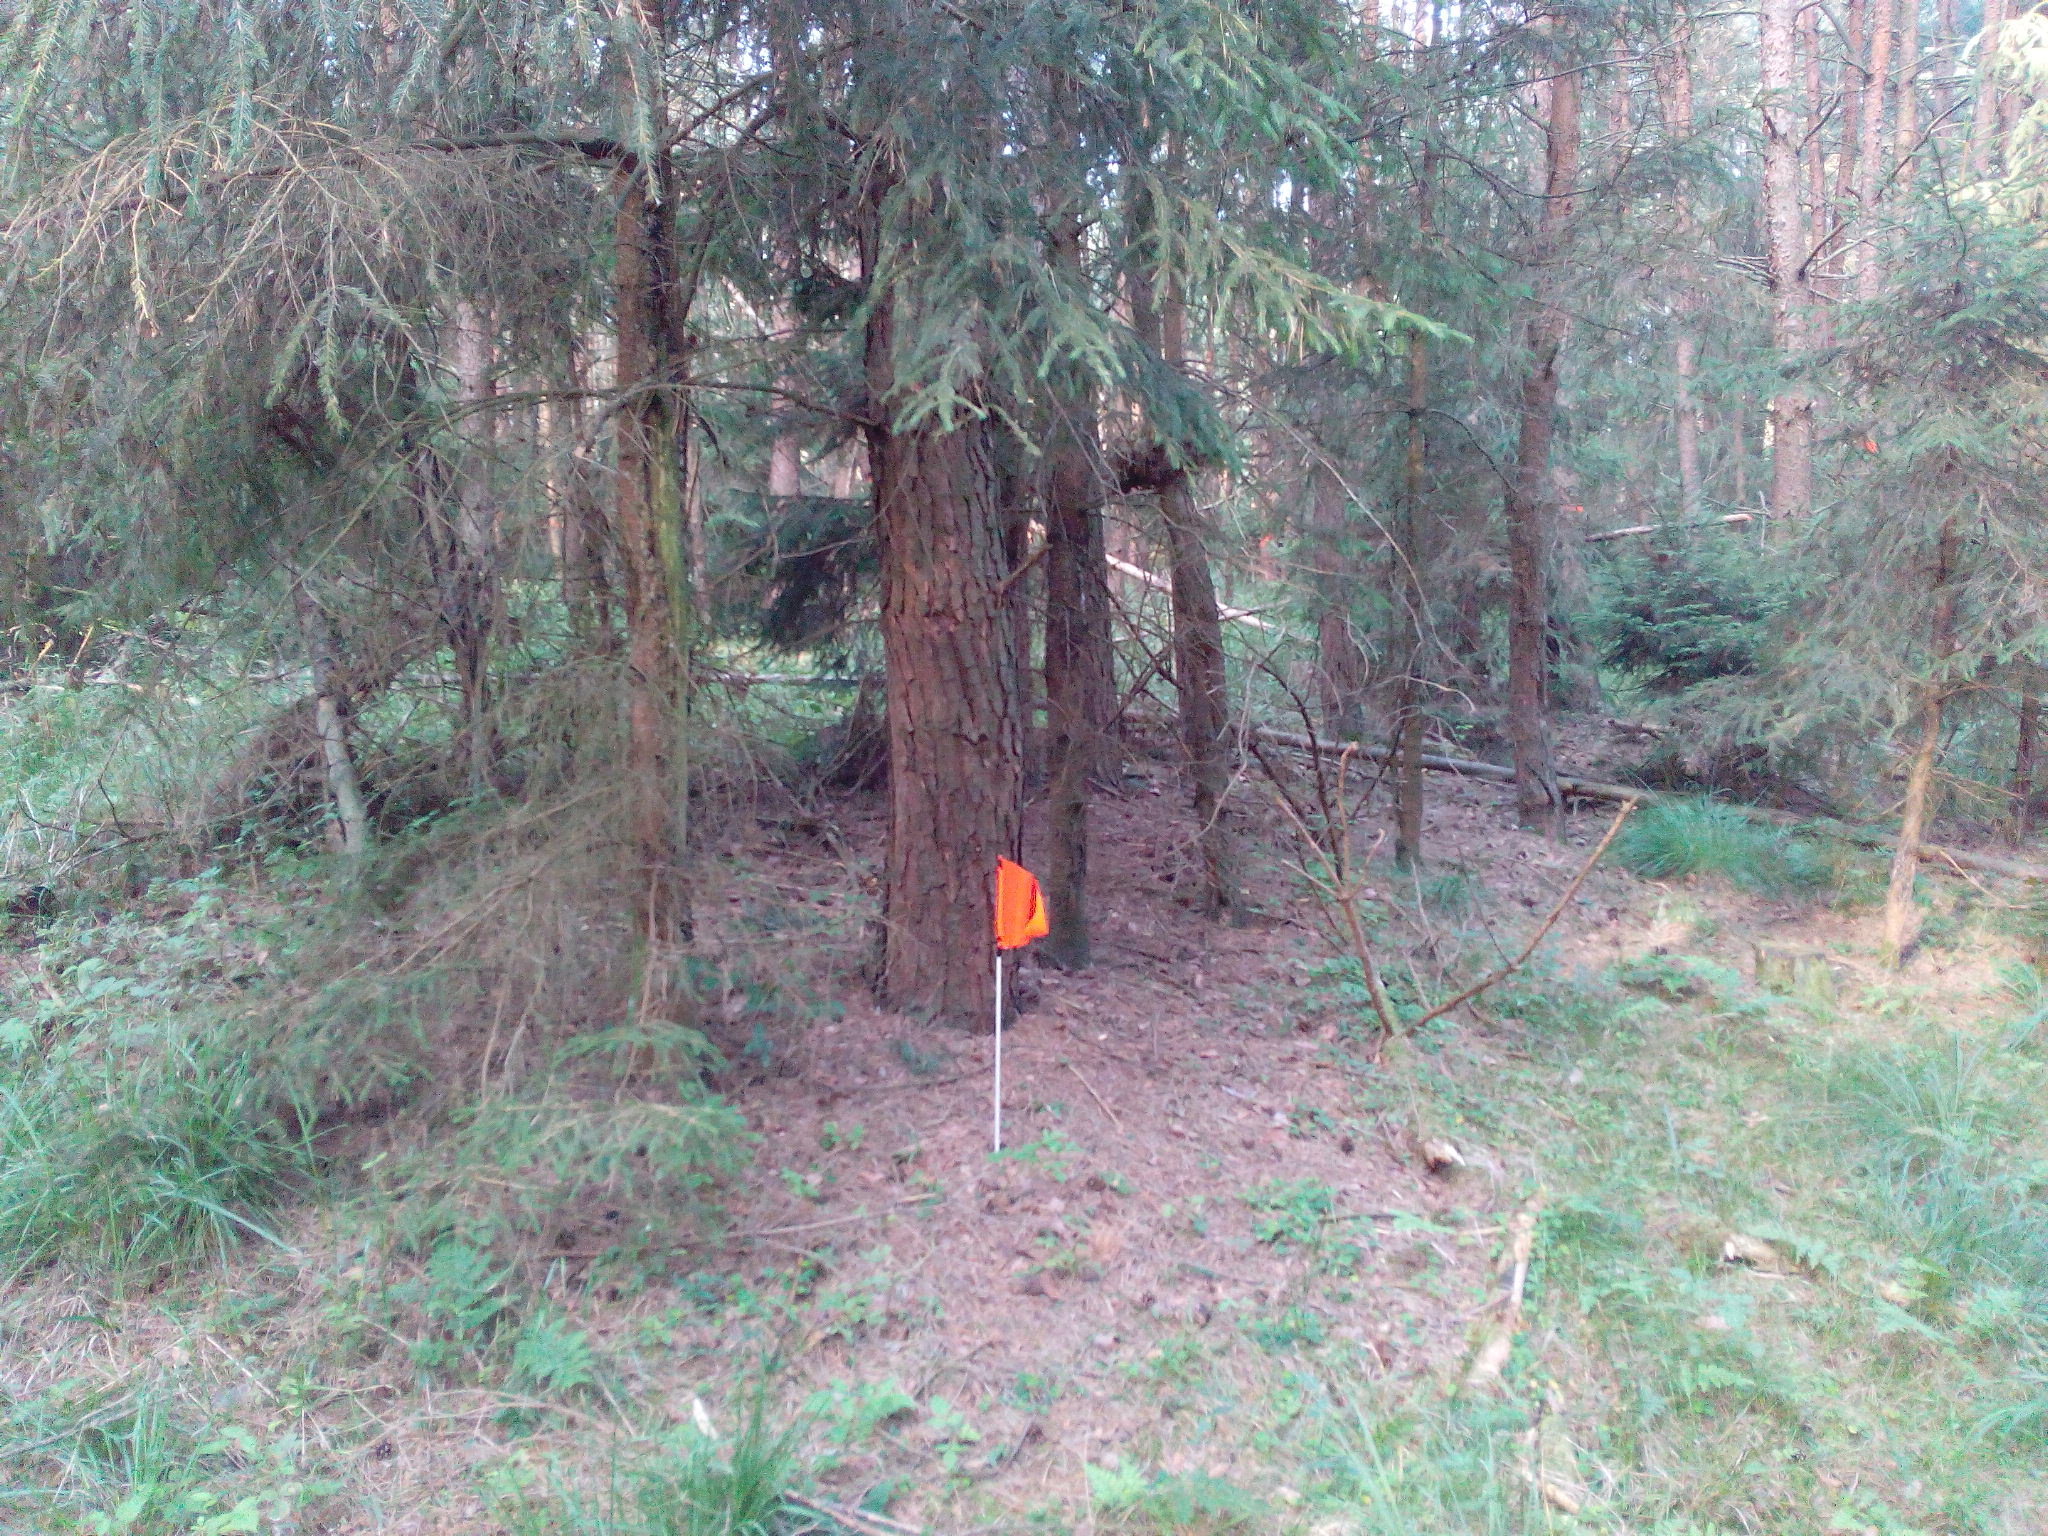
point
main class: Woodland
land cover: Spruce dominated coniferous woodland
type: hemiboreal forest and nemoral coniferous forest and mixed broadleaved-coniferous forest
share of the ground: > 75 %
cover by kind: coniferous forest trees 75 %, herbaceous plants 25 %
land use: Forestry
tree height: > 5 m
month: August
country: DE
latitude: 52.5931
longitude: 9.8967
